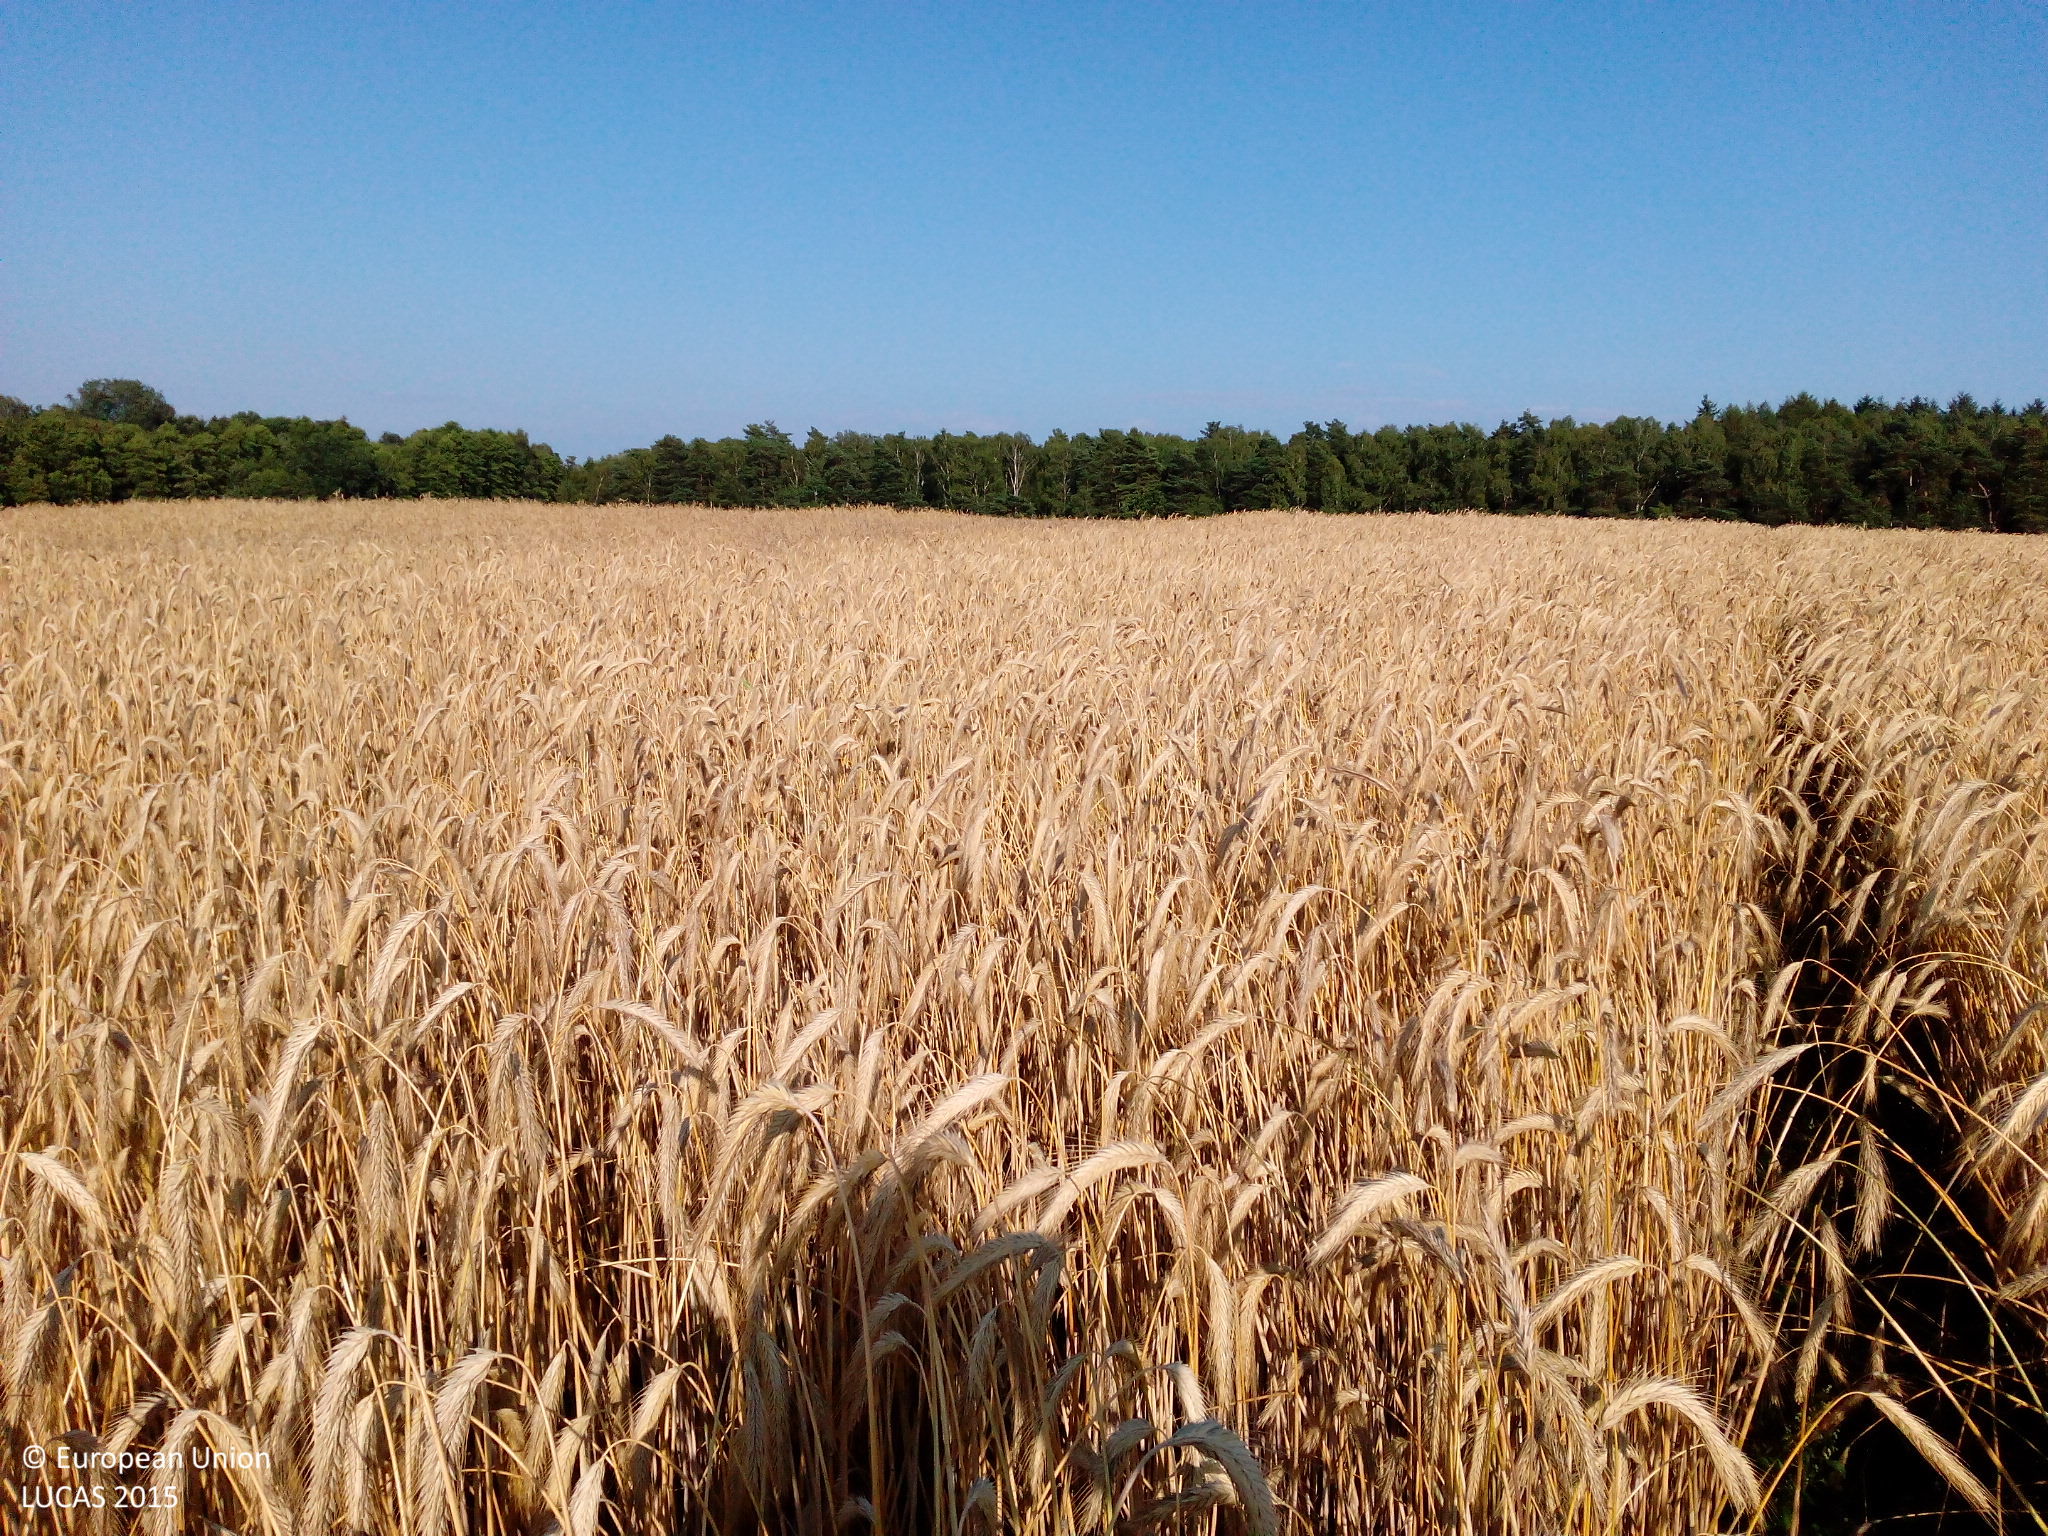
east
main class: Cropland
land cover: Rye
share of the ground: > 75 %
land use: Agriculture (excluding fallow land and kitchen gardens)
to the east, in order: Rye
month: July
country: DE
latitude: 52.3313
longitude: 14.4185
